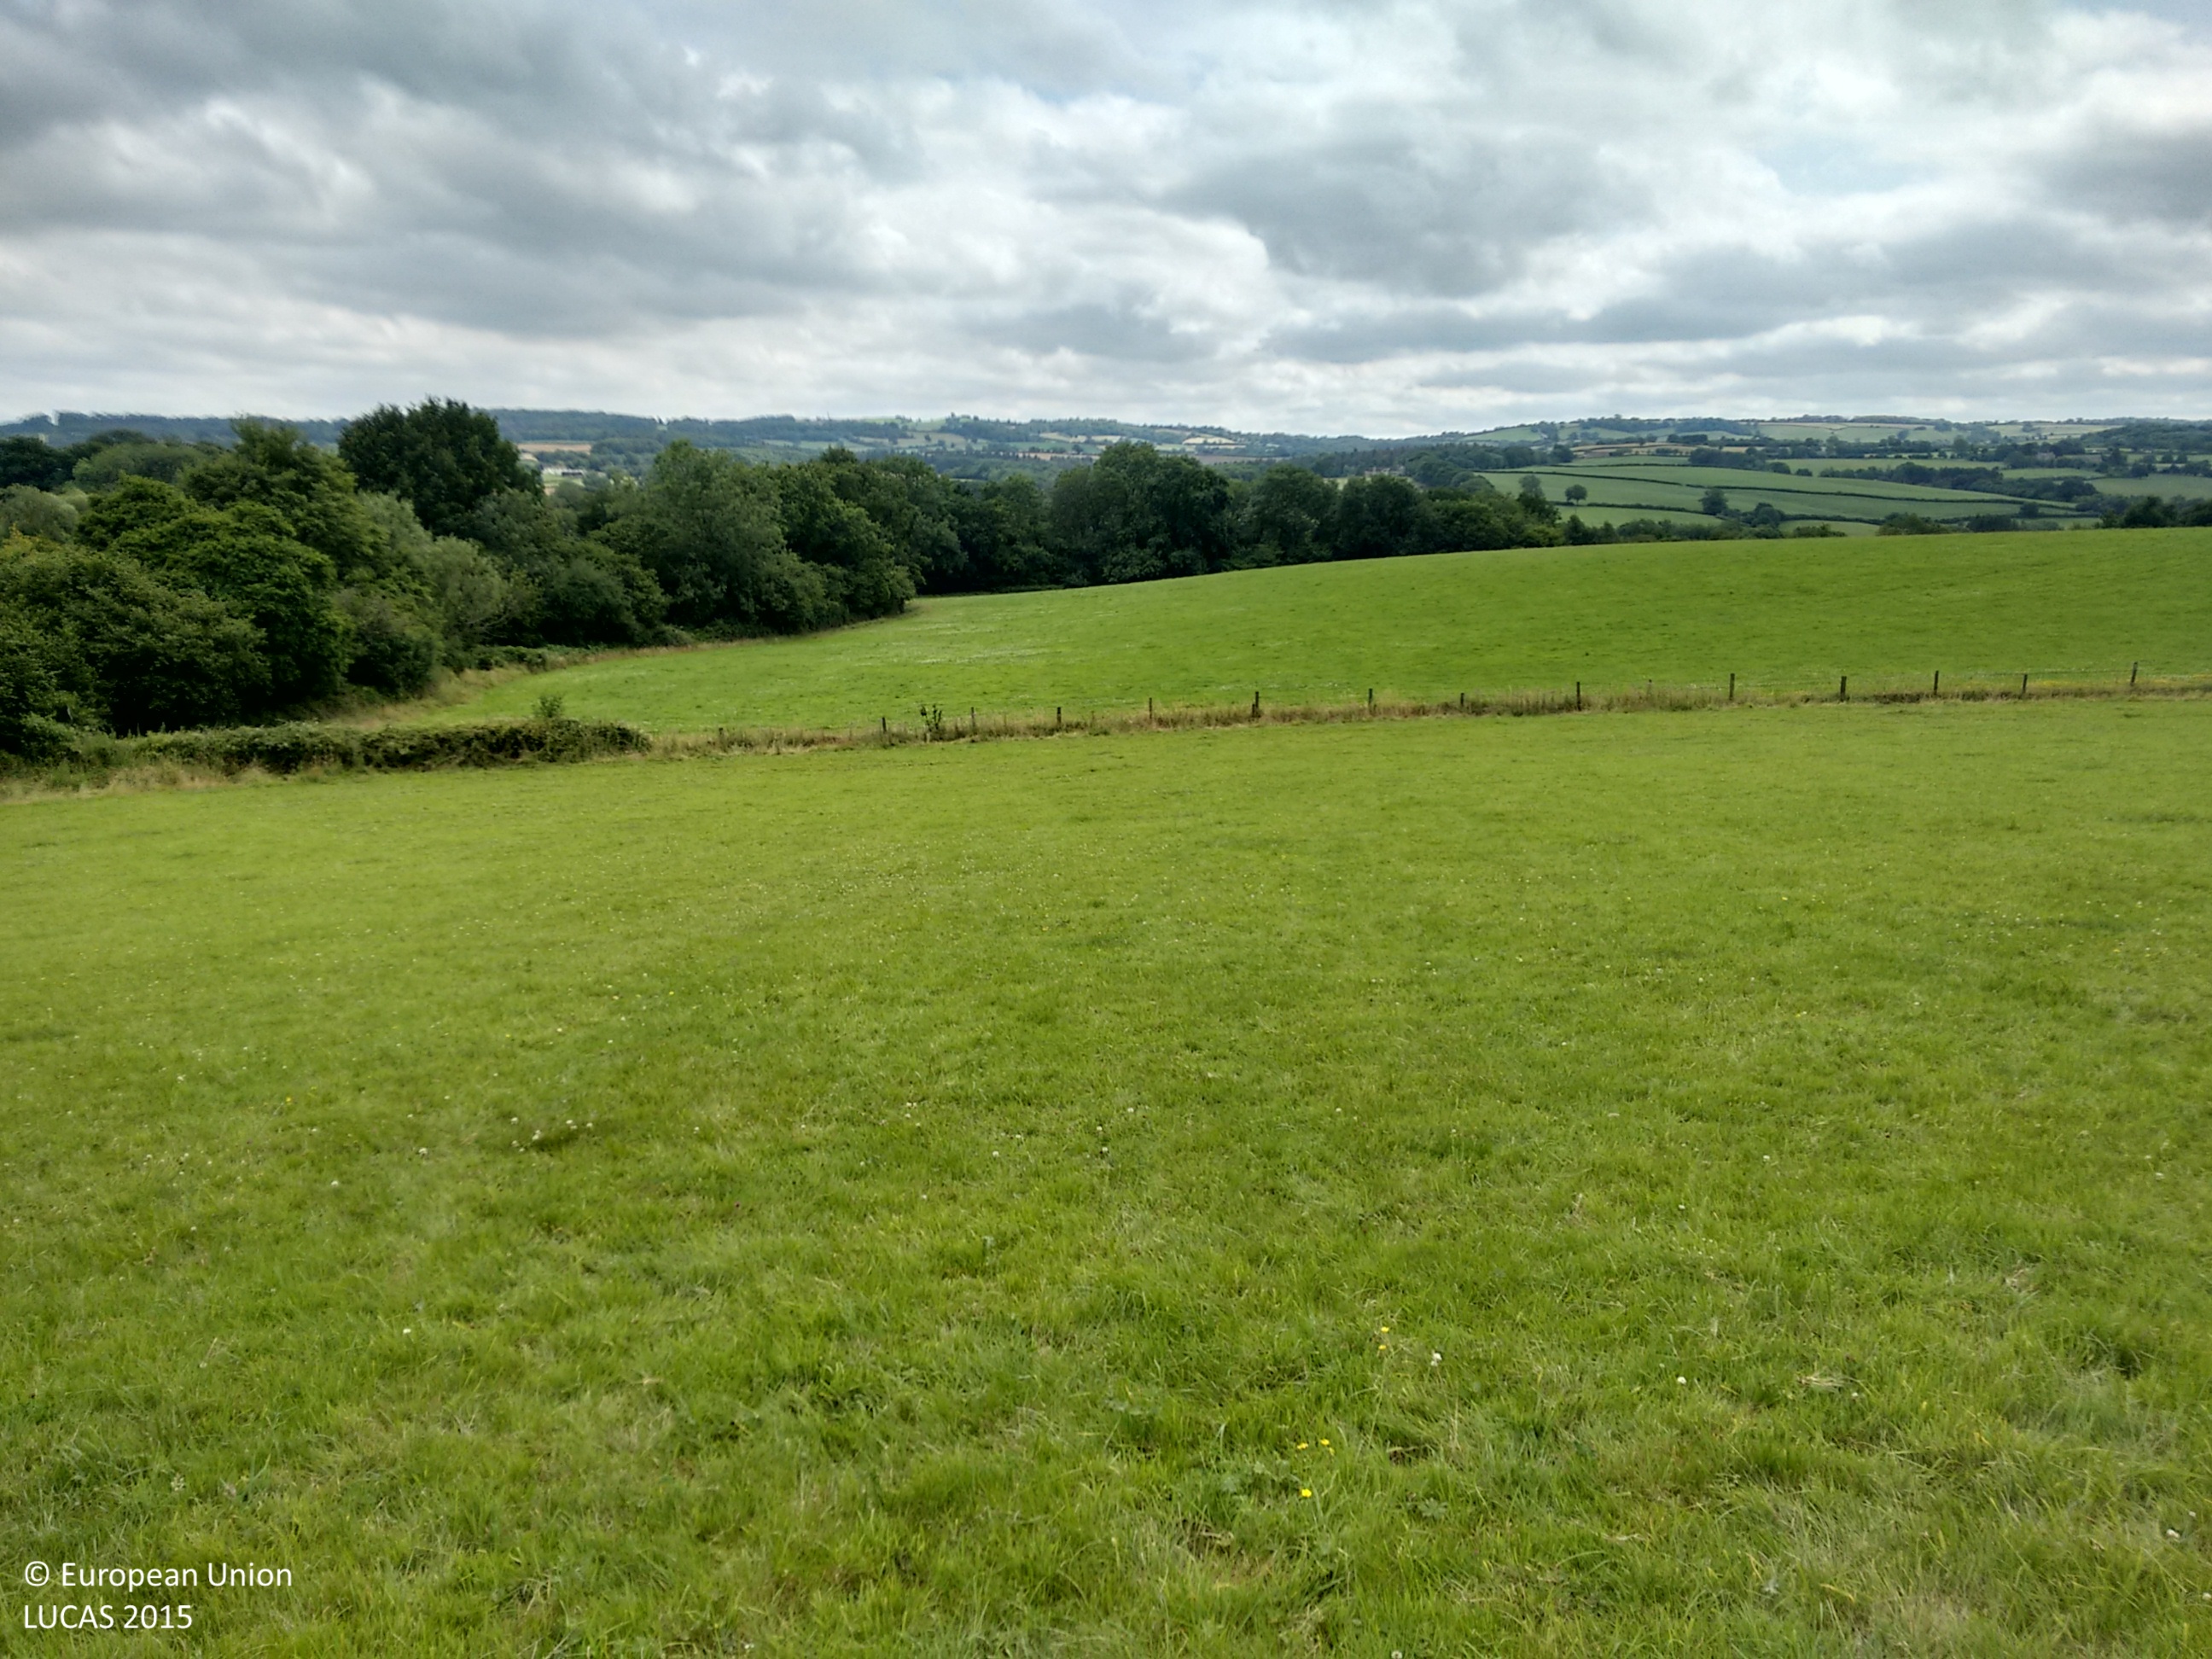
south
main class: Grassland
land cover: Grassland without tree/shrub cover
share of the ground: > 75 %
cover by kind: herbaceous plants 100 %
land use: Agriculture (excluding fallow land and kitchen gardens)
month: July
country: GB
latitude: 51.3832
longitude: -2.5245
